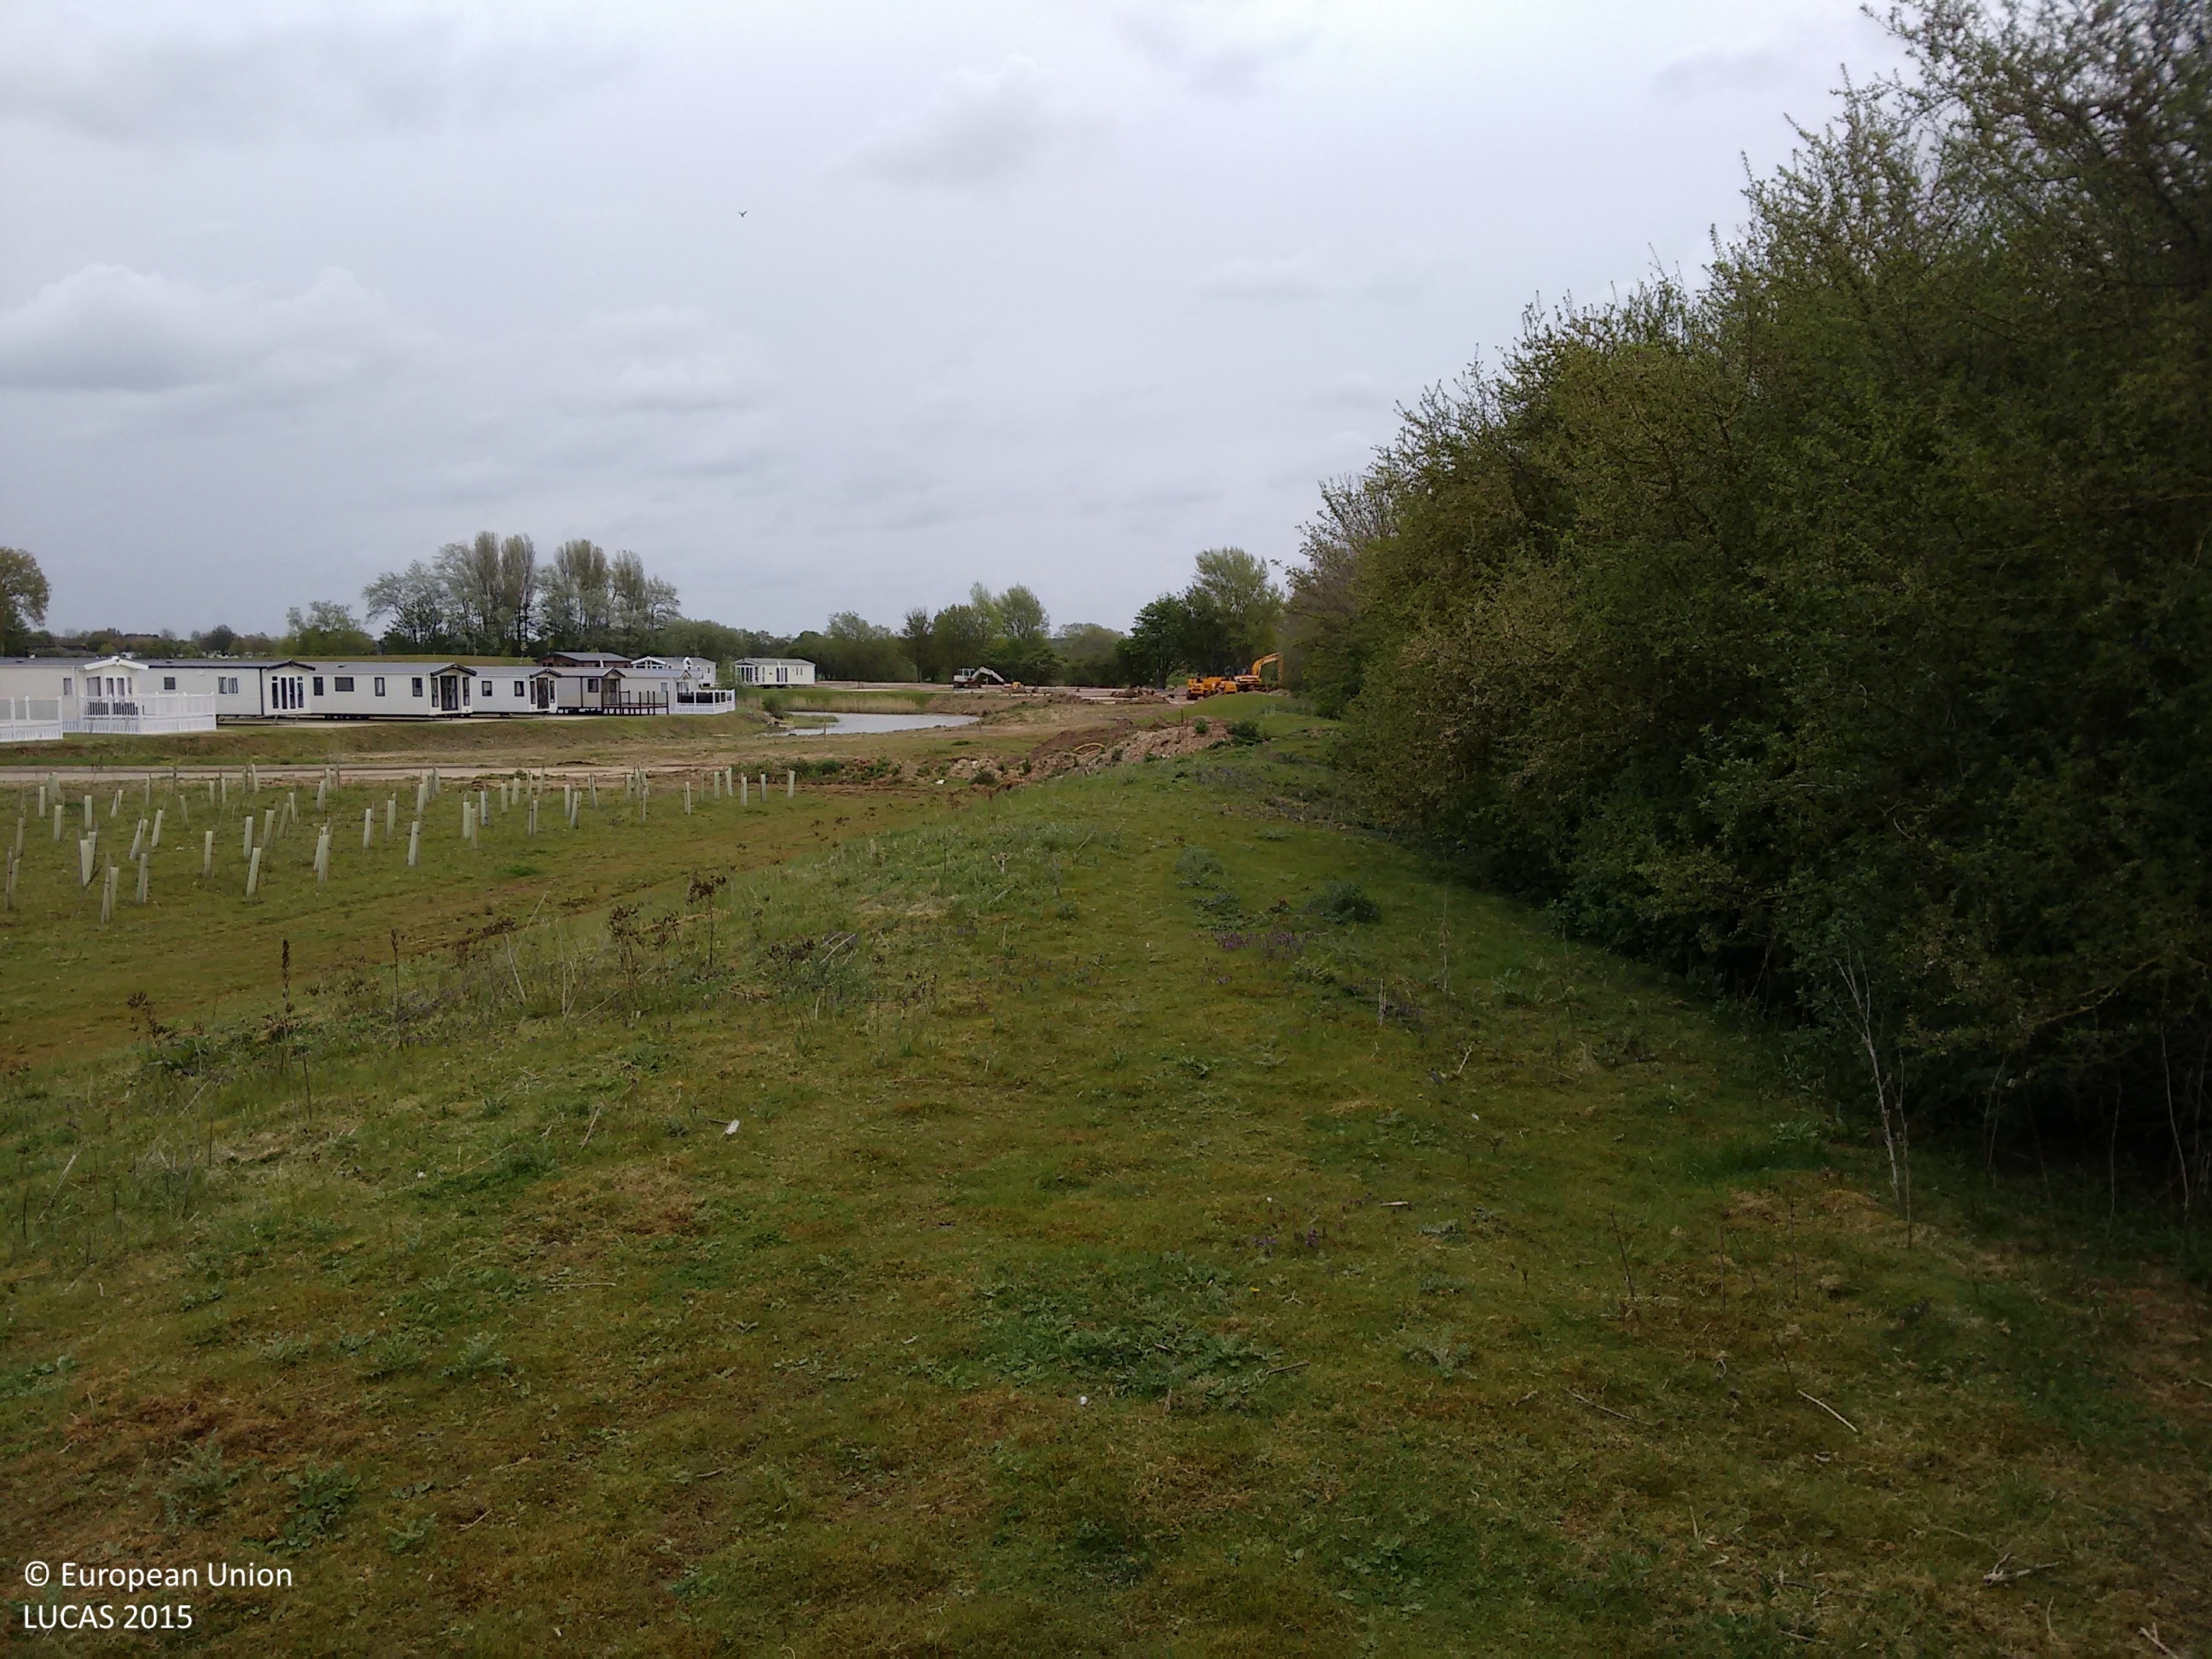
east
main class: Grassland
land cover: Grassland without tree/shrub cover
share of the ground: > 75 %
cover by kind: herbaceous plants 100 %
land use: Amenities, museums, leisure
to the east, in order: Grassland without tree/shrub cover; Artificial constructions in urban areas; Ponds and wetlands
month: May
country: GB
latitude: 53.9036
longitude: -0.3083
